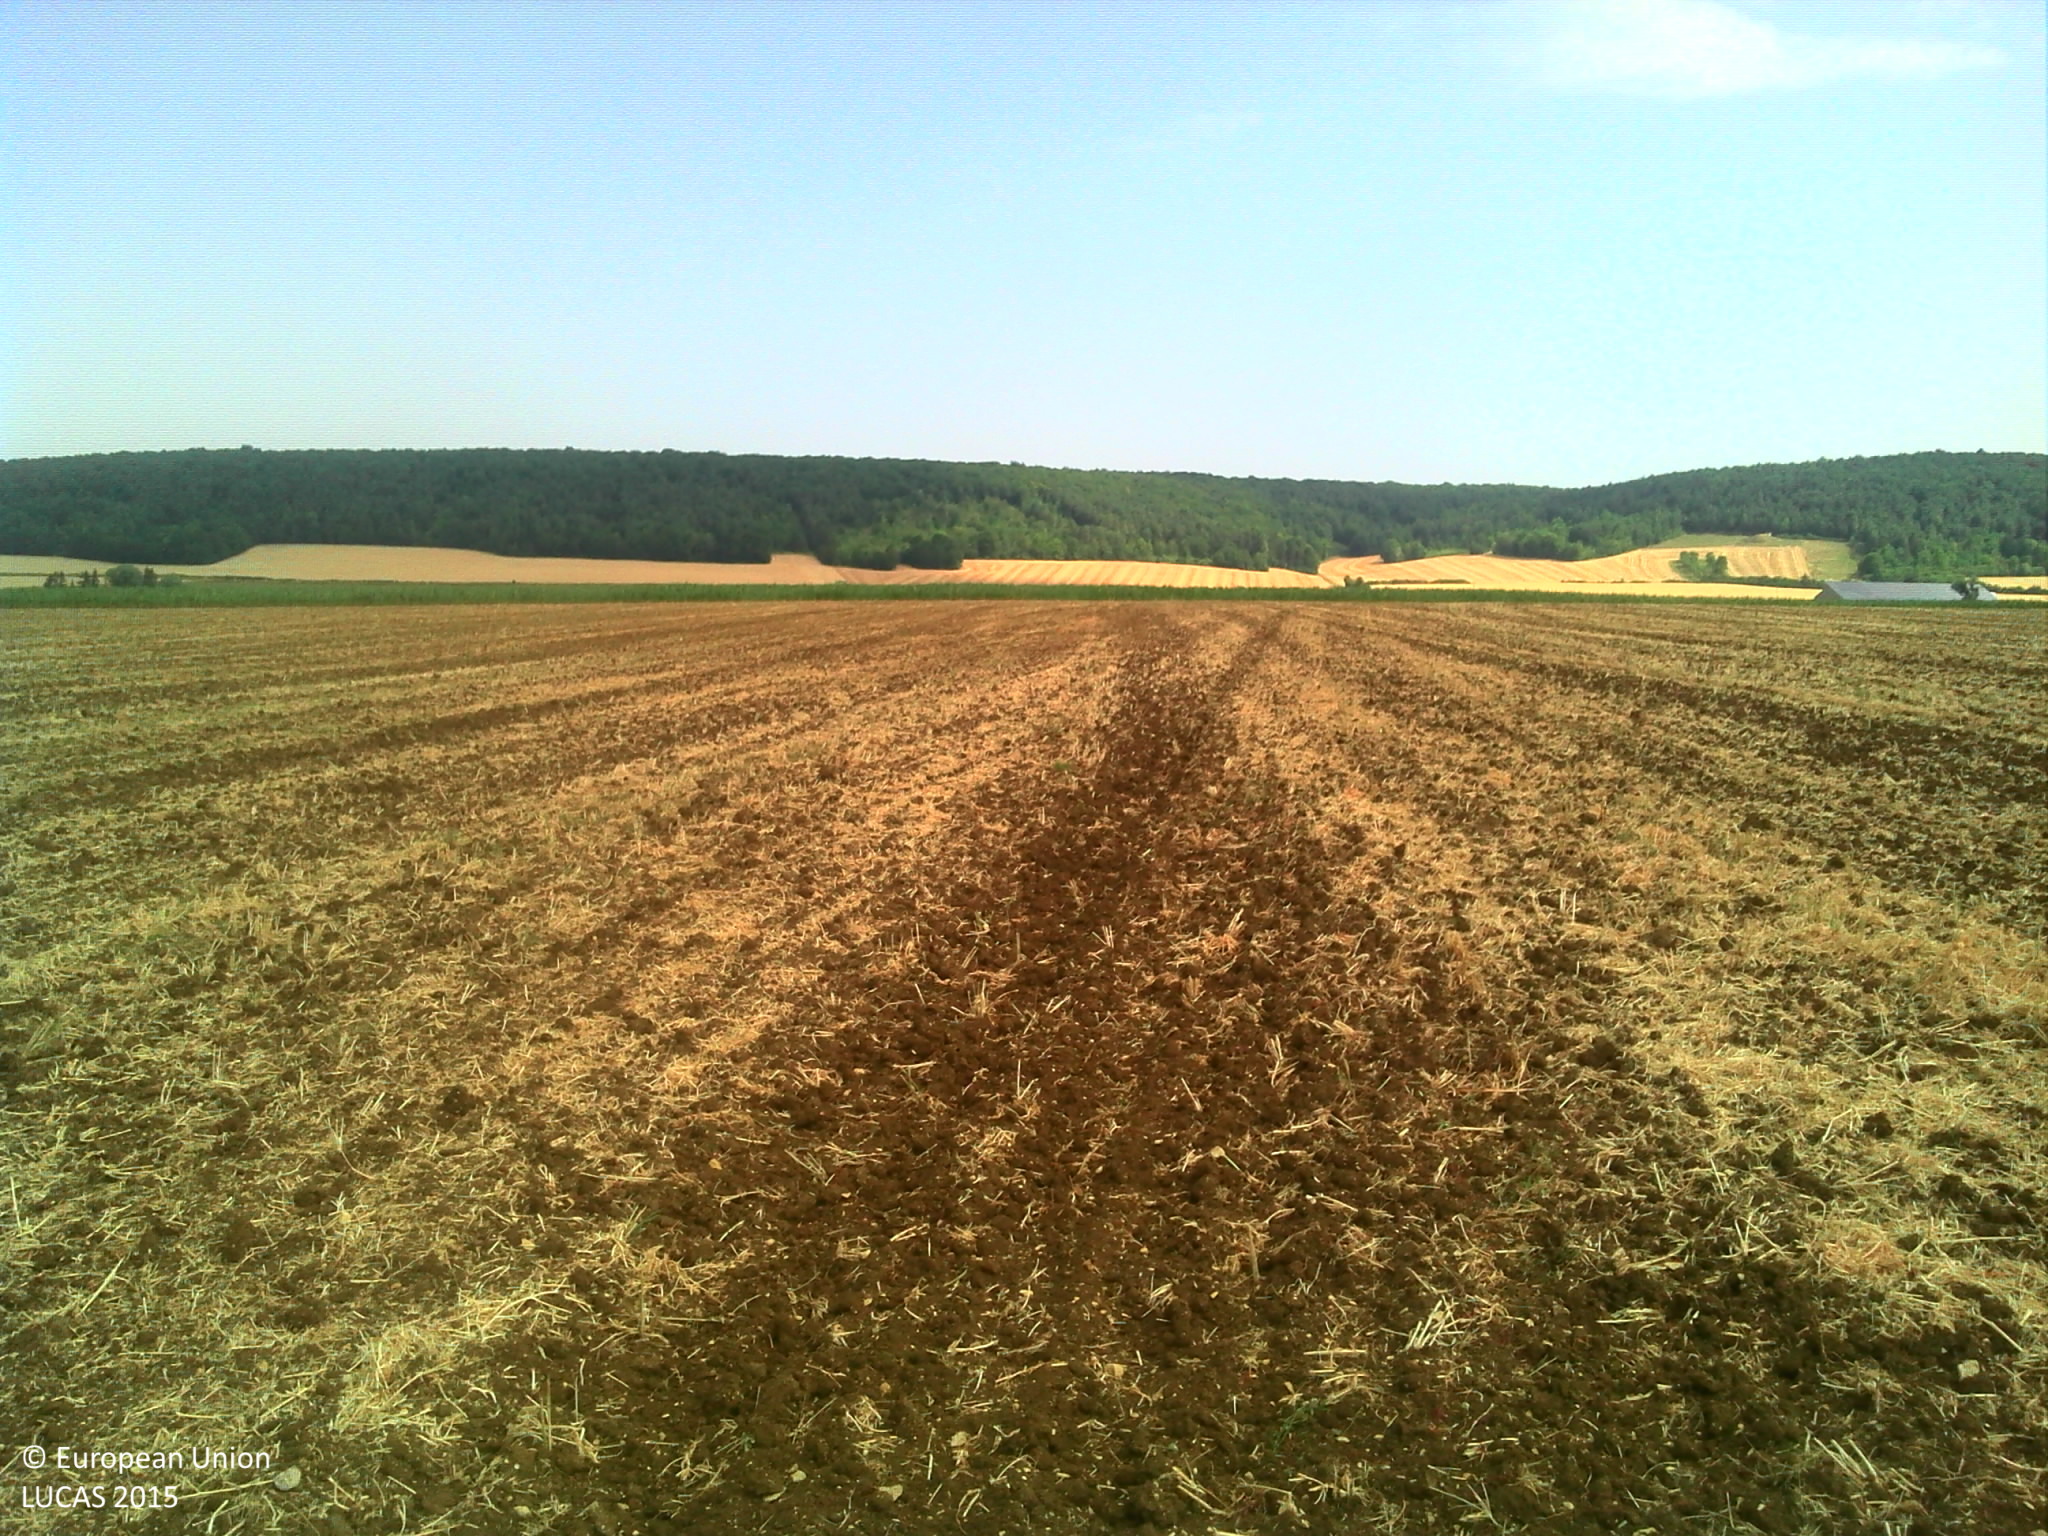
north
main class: Cropland
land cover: Dry pulses
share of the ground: 10 - 25 %
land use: Agriculture (excluding fallow land and kitchen gardens)
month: July
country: FR
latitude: 47.9766
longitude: 4.8412
